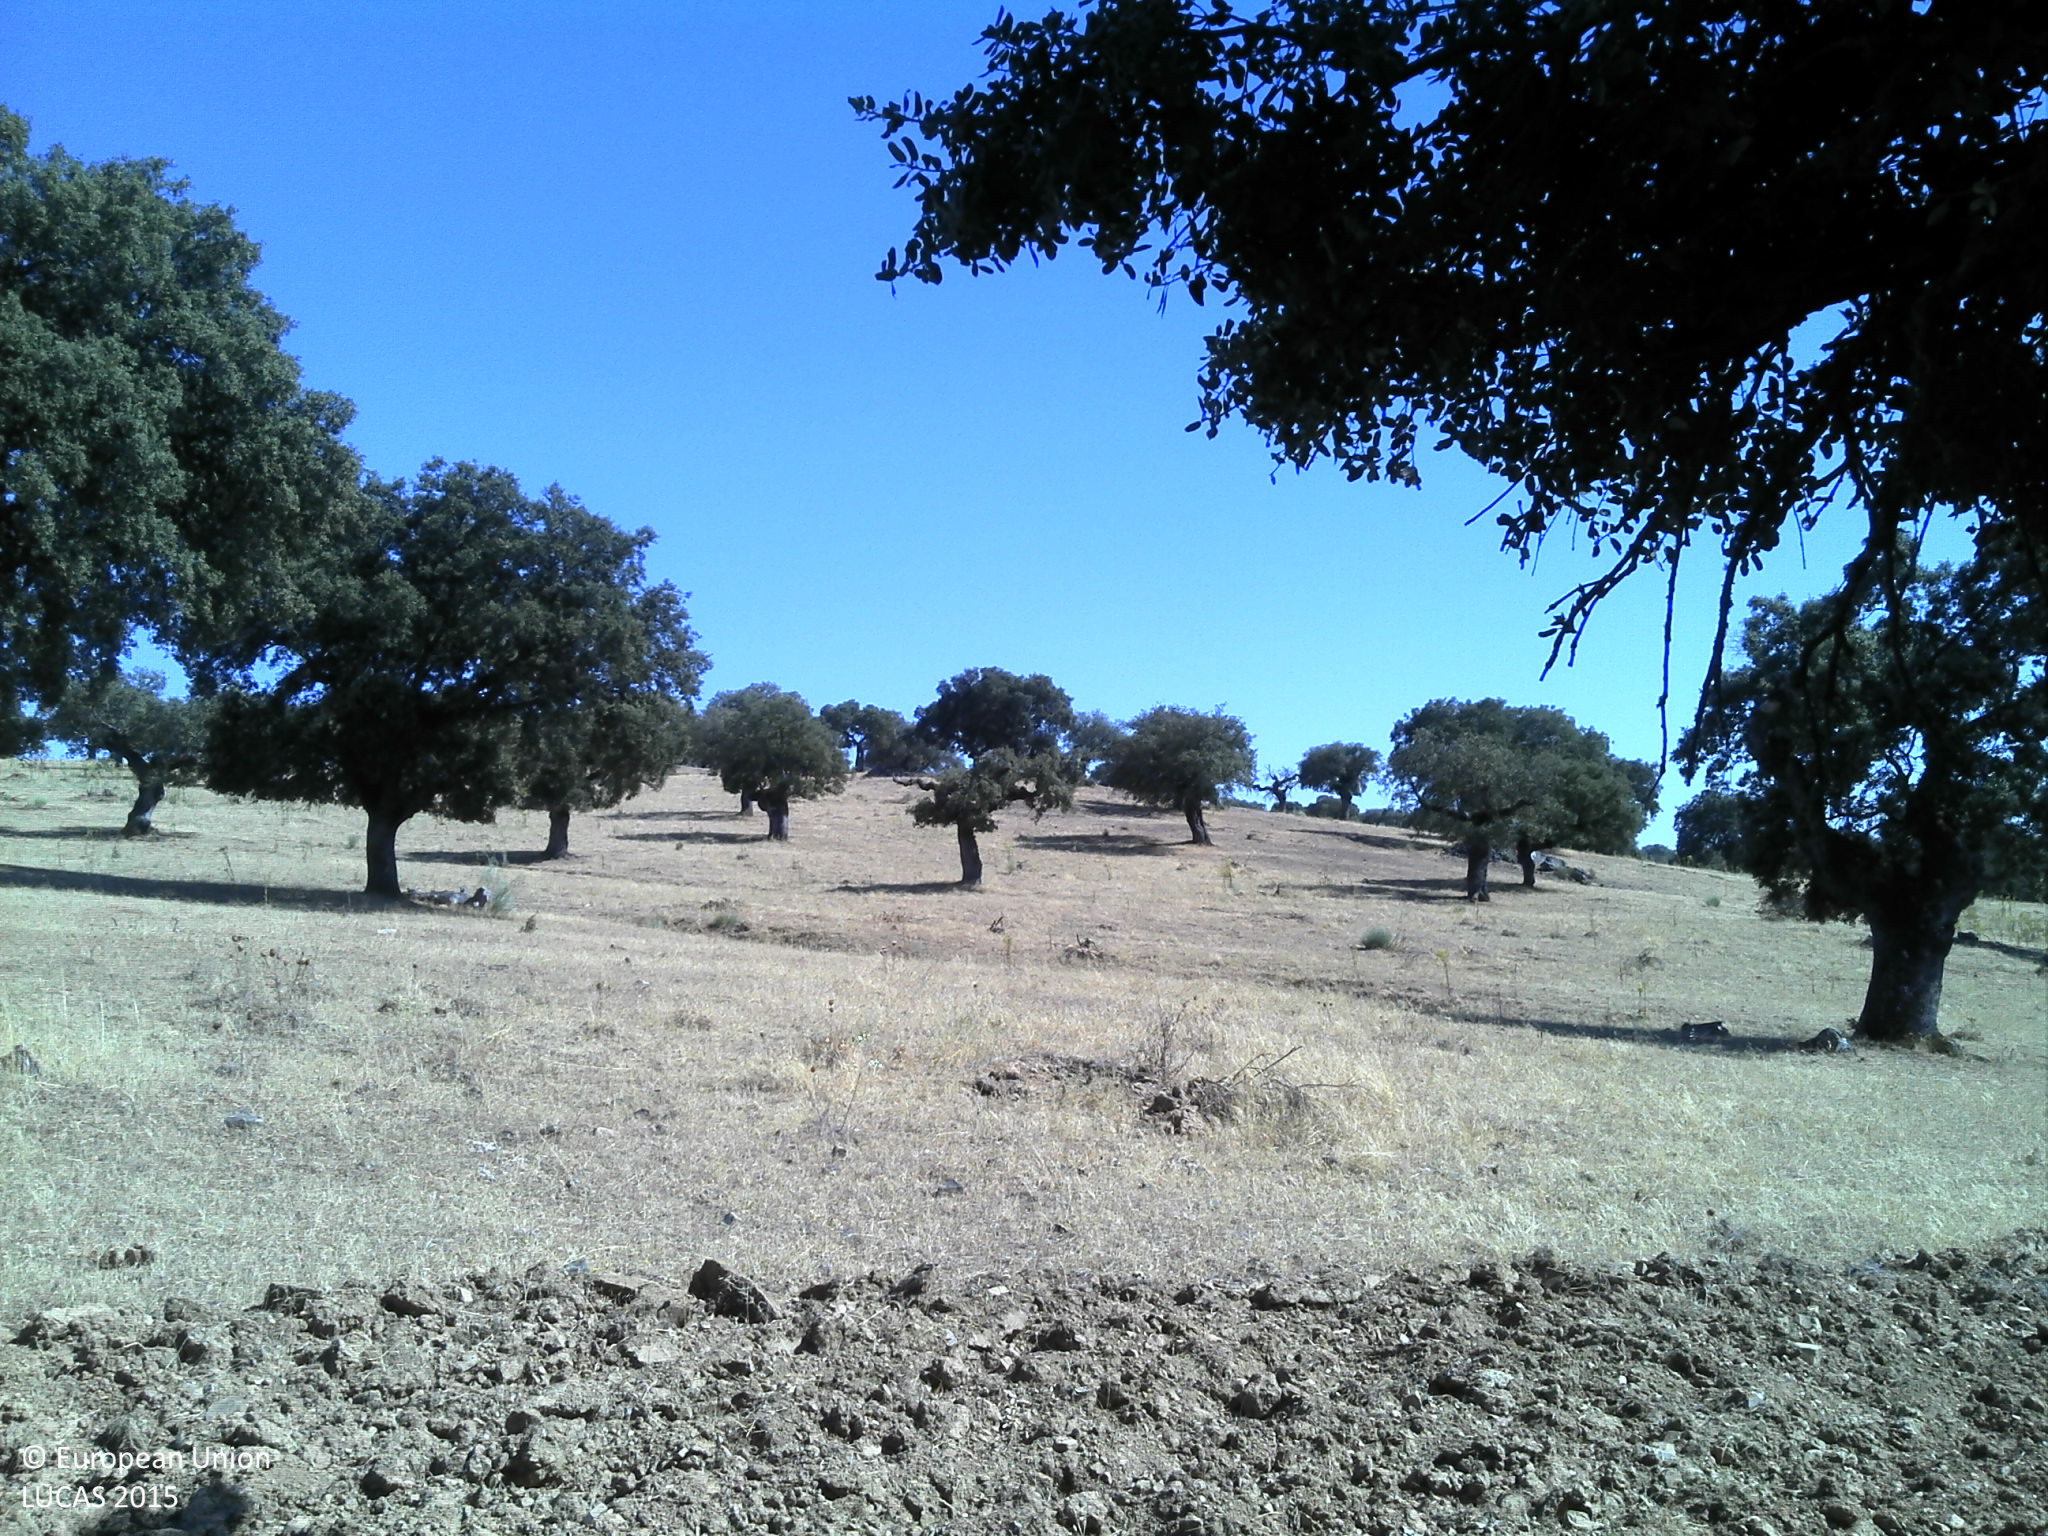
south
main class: Woodland
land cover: Broadleaved woodland
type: broadleaved evergreen forest
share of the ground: 10 - 25 %
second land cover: Grassland without tree/shrub cover
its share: 10 - 25 %
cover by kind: unconsolidated bare surface 80 %, broadleaved forest trees 10 %, herbaceous plants 10 %
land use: Forestry
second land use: Agriculture (excluding fallow land and kitchen gardens)
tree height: > 5 m
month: July
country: PT
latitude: 39.0502
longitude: -7.4981
